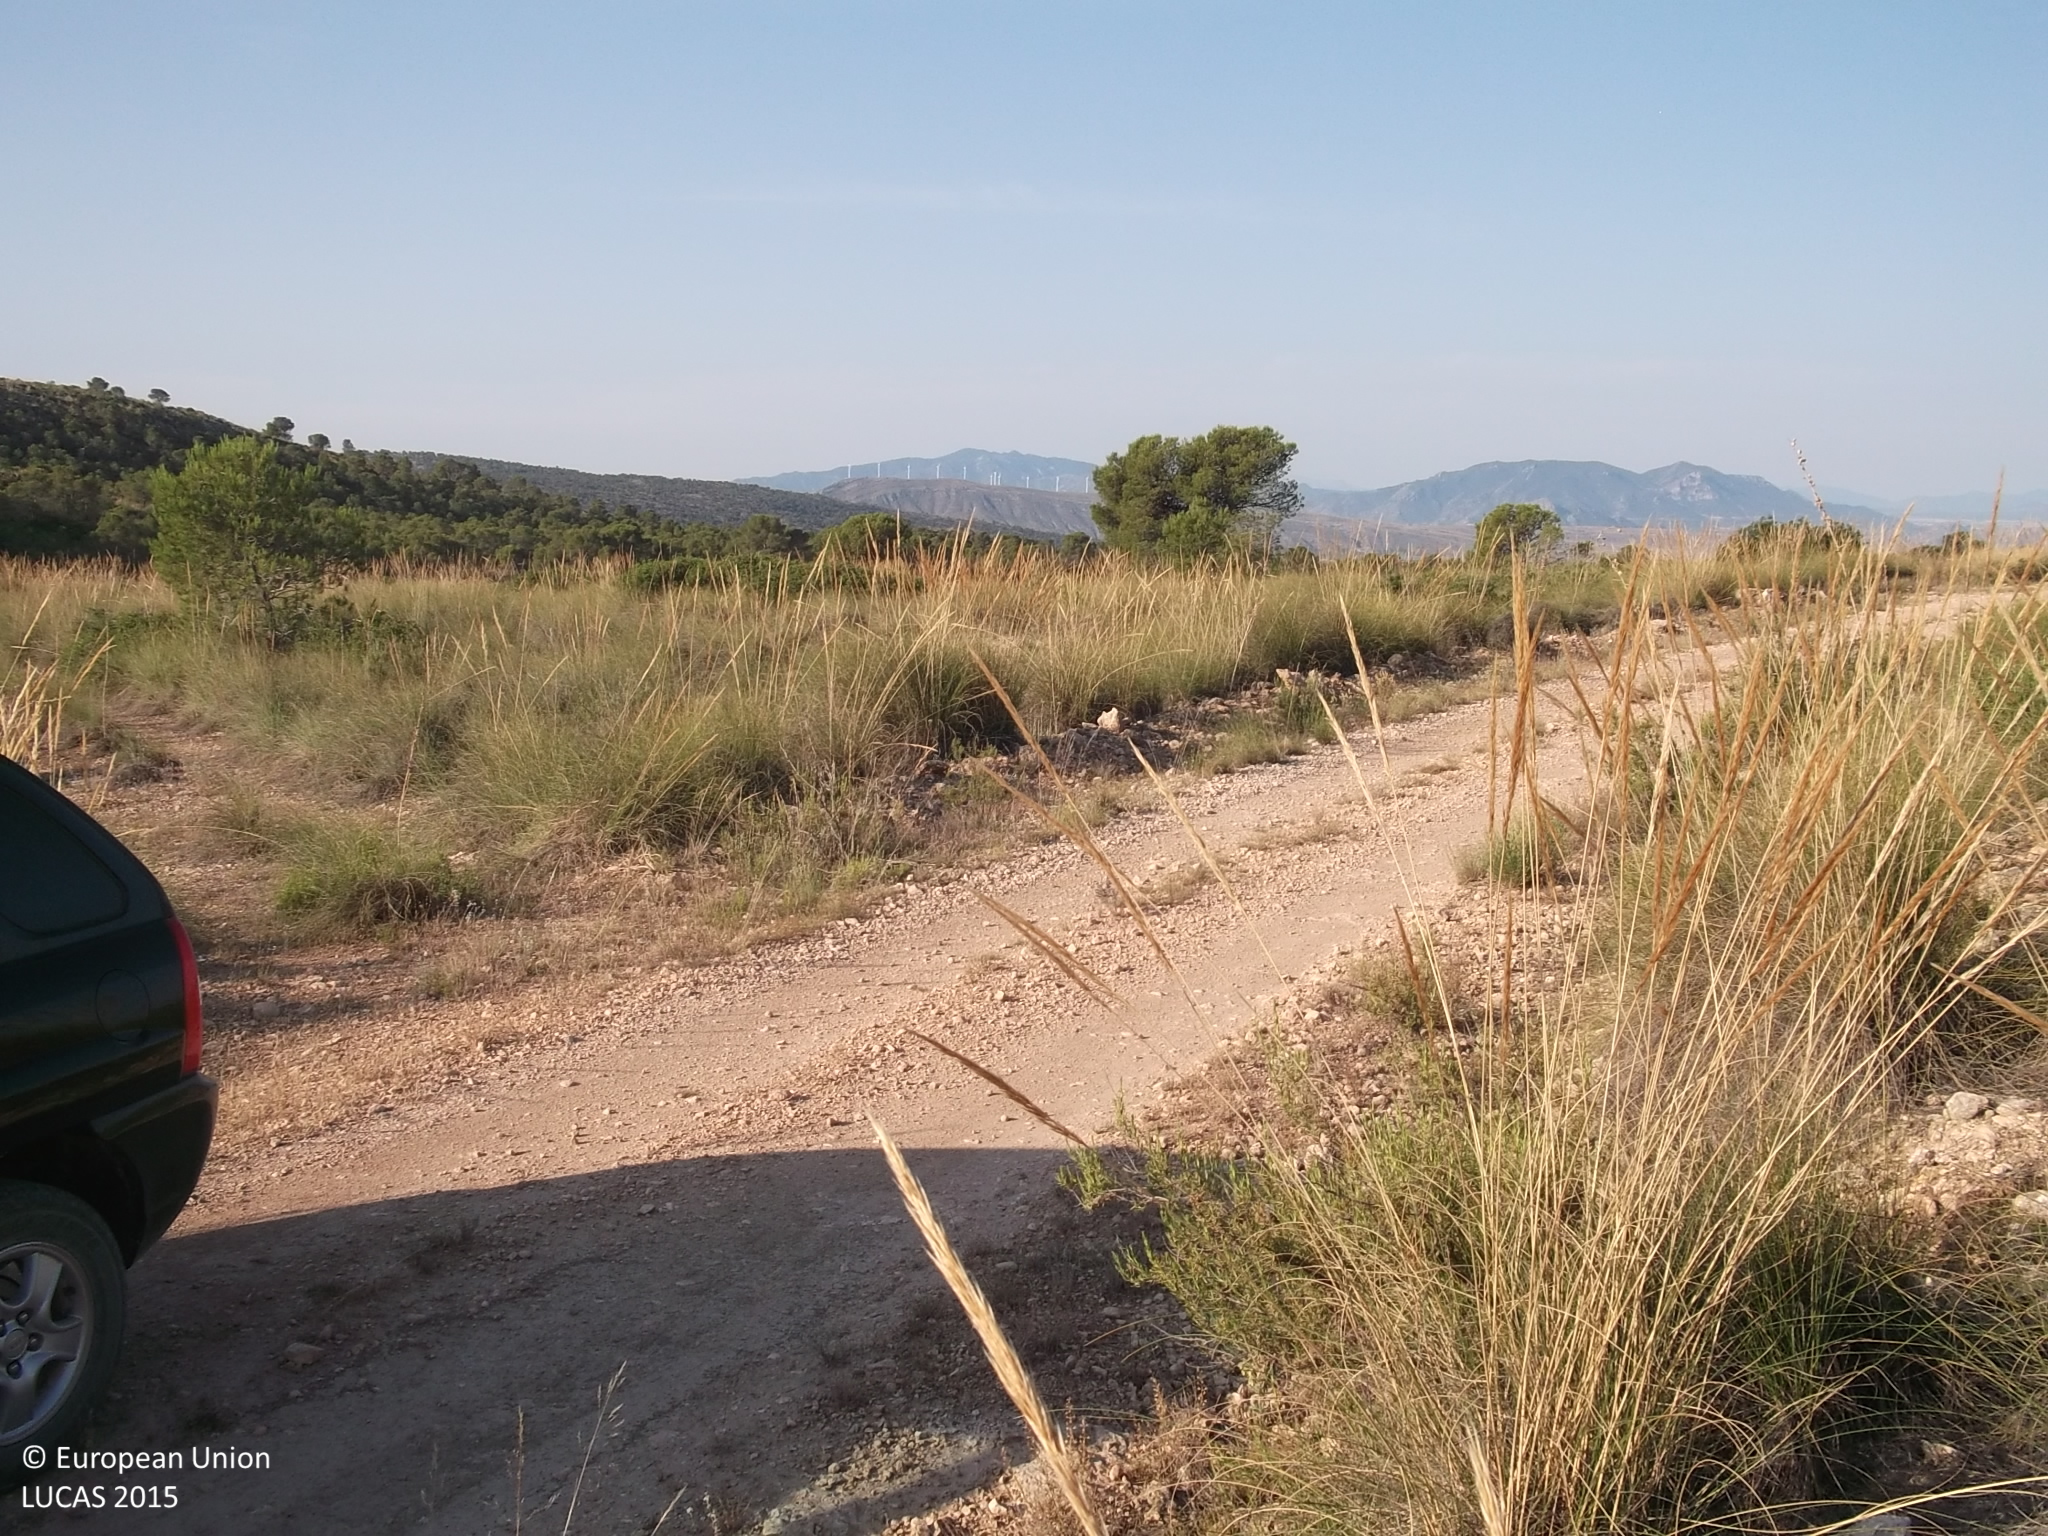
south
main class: Grassland
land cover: Grassland with sparse tree/shrub cover
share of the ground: 25 - 50 %
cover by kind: herbaceous plants 45 %, consolidated bare surface 40 %, shrubs 10 %, coniferous forest trees 5 %
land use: Abandoned areas
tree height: > 5 m
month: June
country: ES
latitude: 38.3458
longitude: -1.3512
